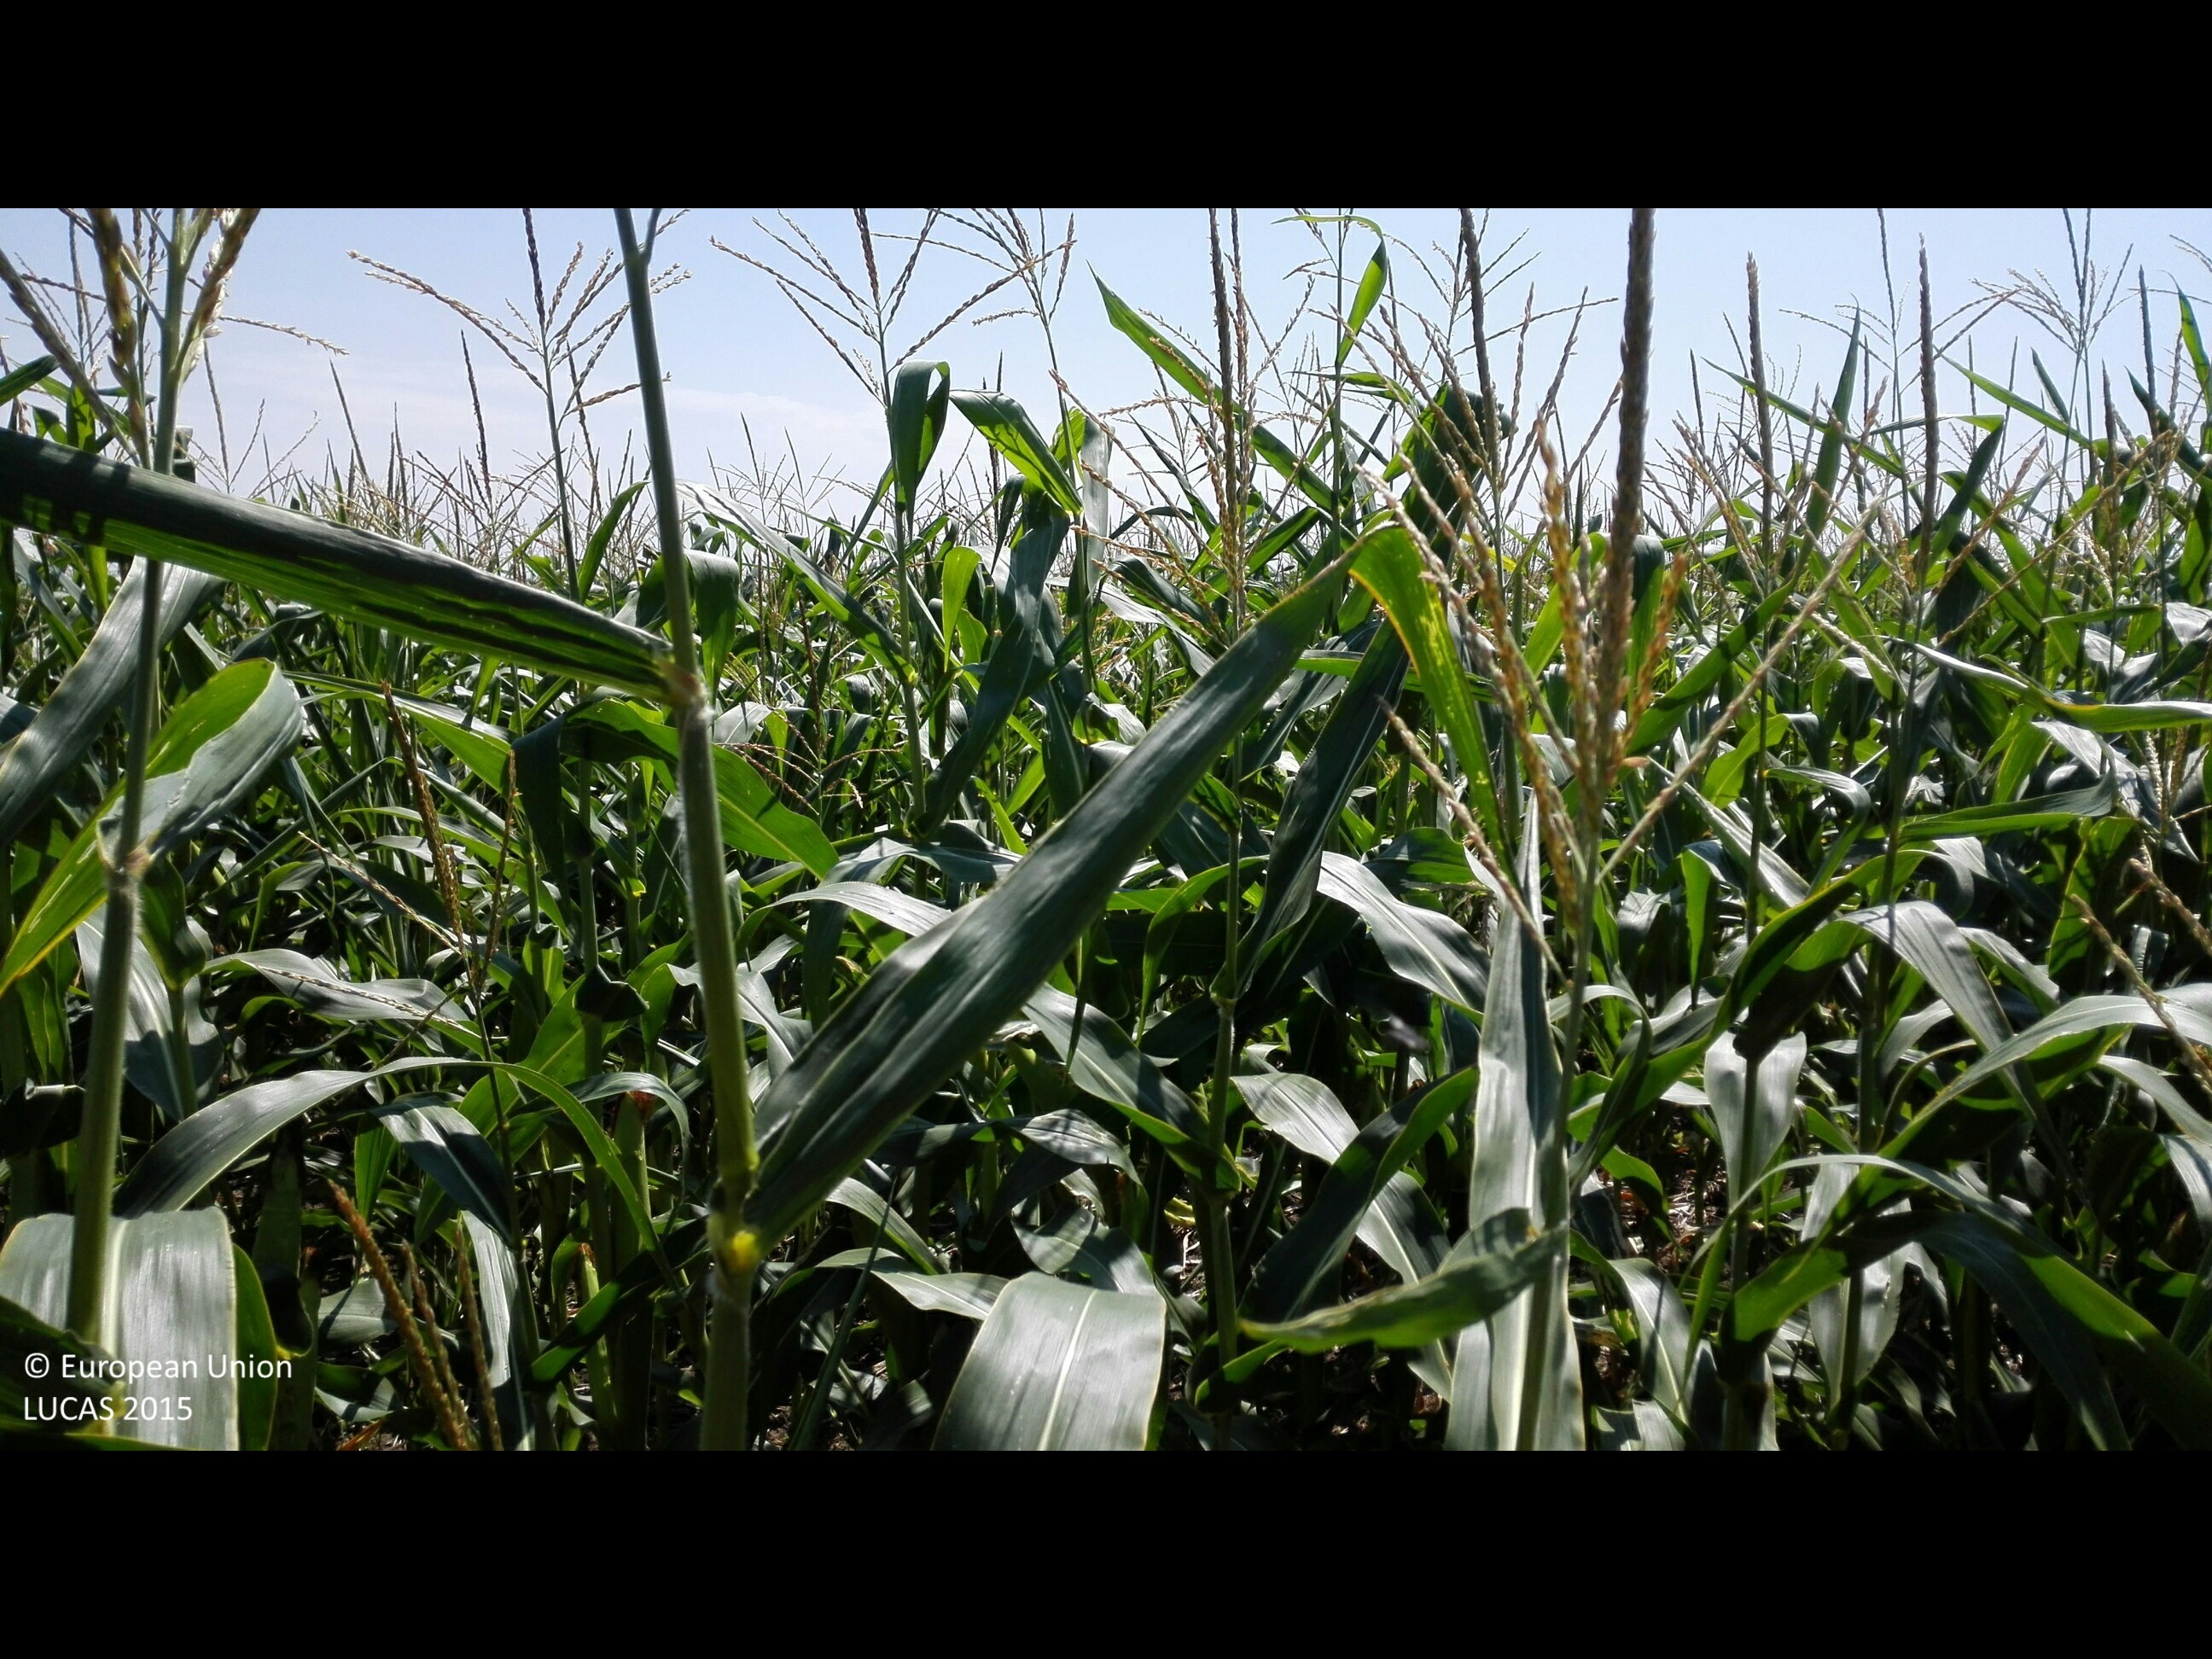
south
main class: Cropland
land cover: Maize
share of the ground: > 75 %
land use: Agriculture (excluding fallow land and kitchen gardens)
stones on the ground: < 10 %
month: July
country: HU
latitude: 47.2249
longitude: 21.2775
